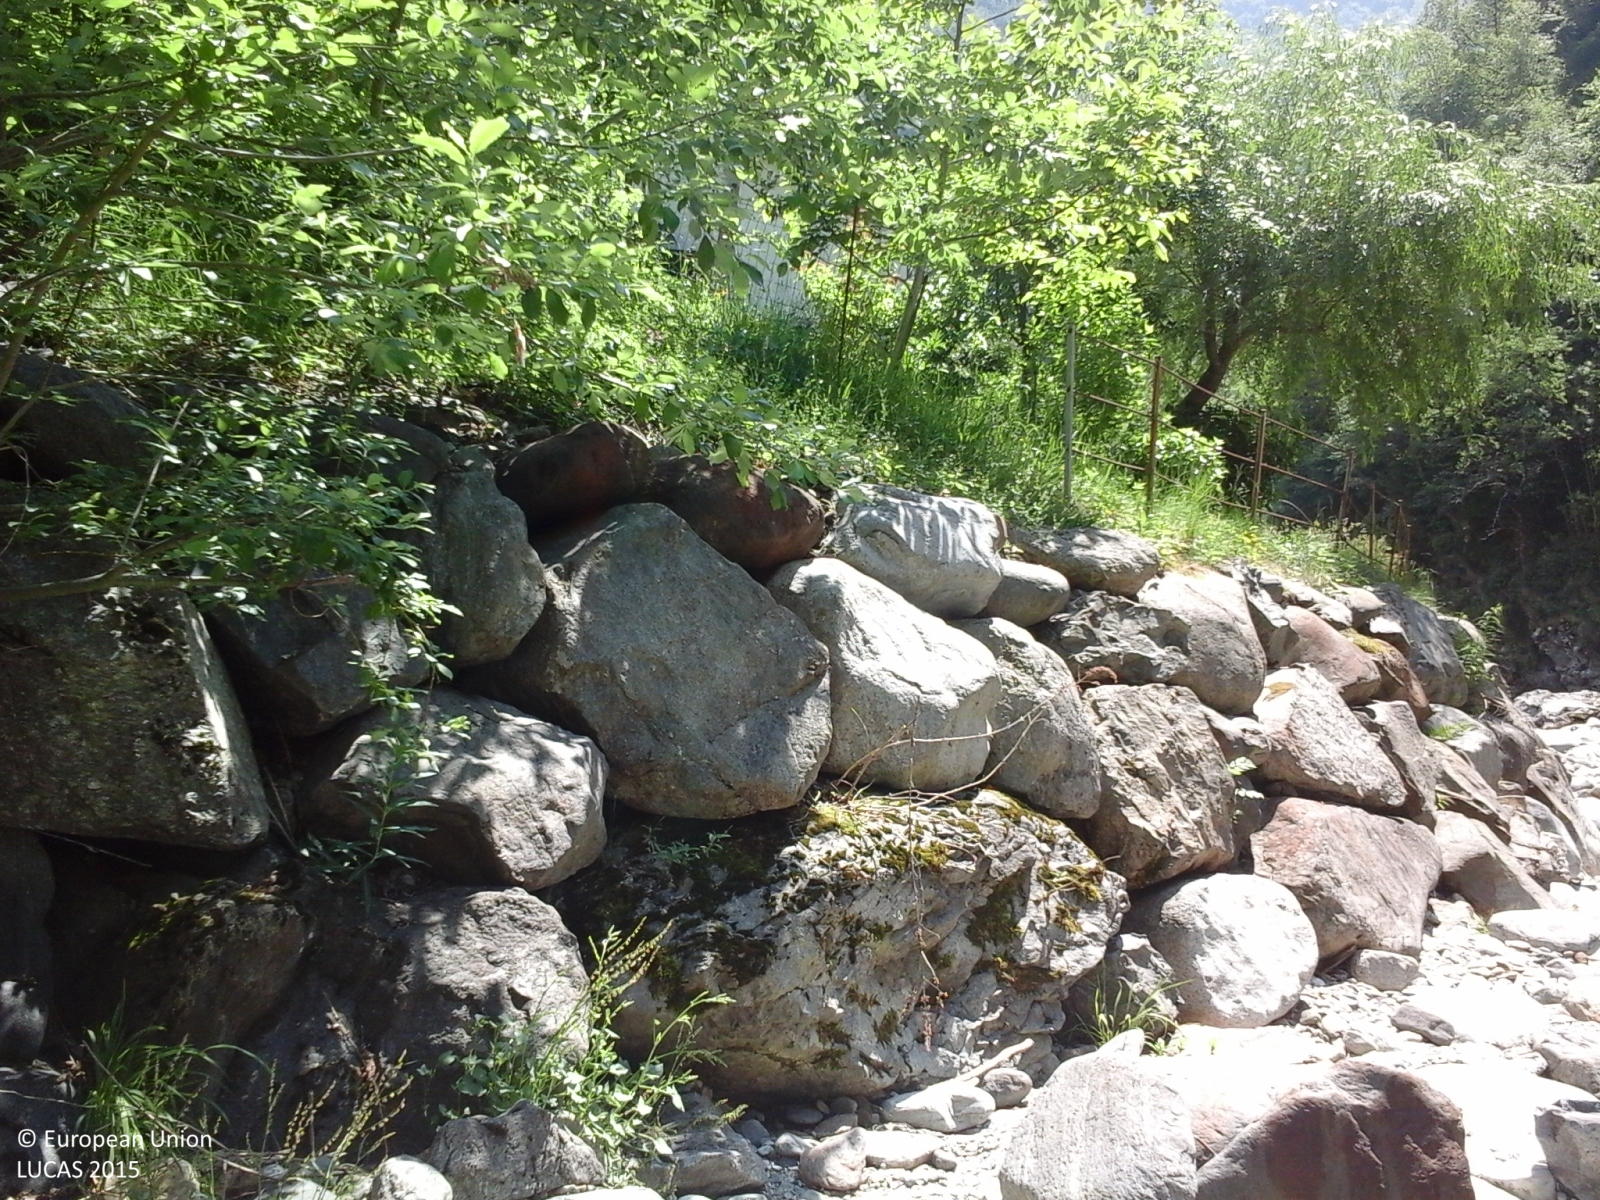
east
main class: Woodland
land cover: Broadleaved woodland
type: mesophytic deciduous forest
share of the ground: > 75 %
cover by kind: broadleaved forest trees 100 %
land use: Forestry
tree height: > 5 m
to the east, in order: Broadleaved woodland; Inland fresh running water; Broadleaved woodland; Artificial constructions in urban areas; Grassland with sparse tree/shrub cover; Grassland without tree/shrub cover; Grassland with sparse tree/shrub cover
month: June
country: IT
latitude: 45.8673
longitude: 8.1863
